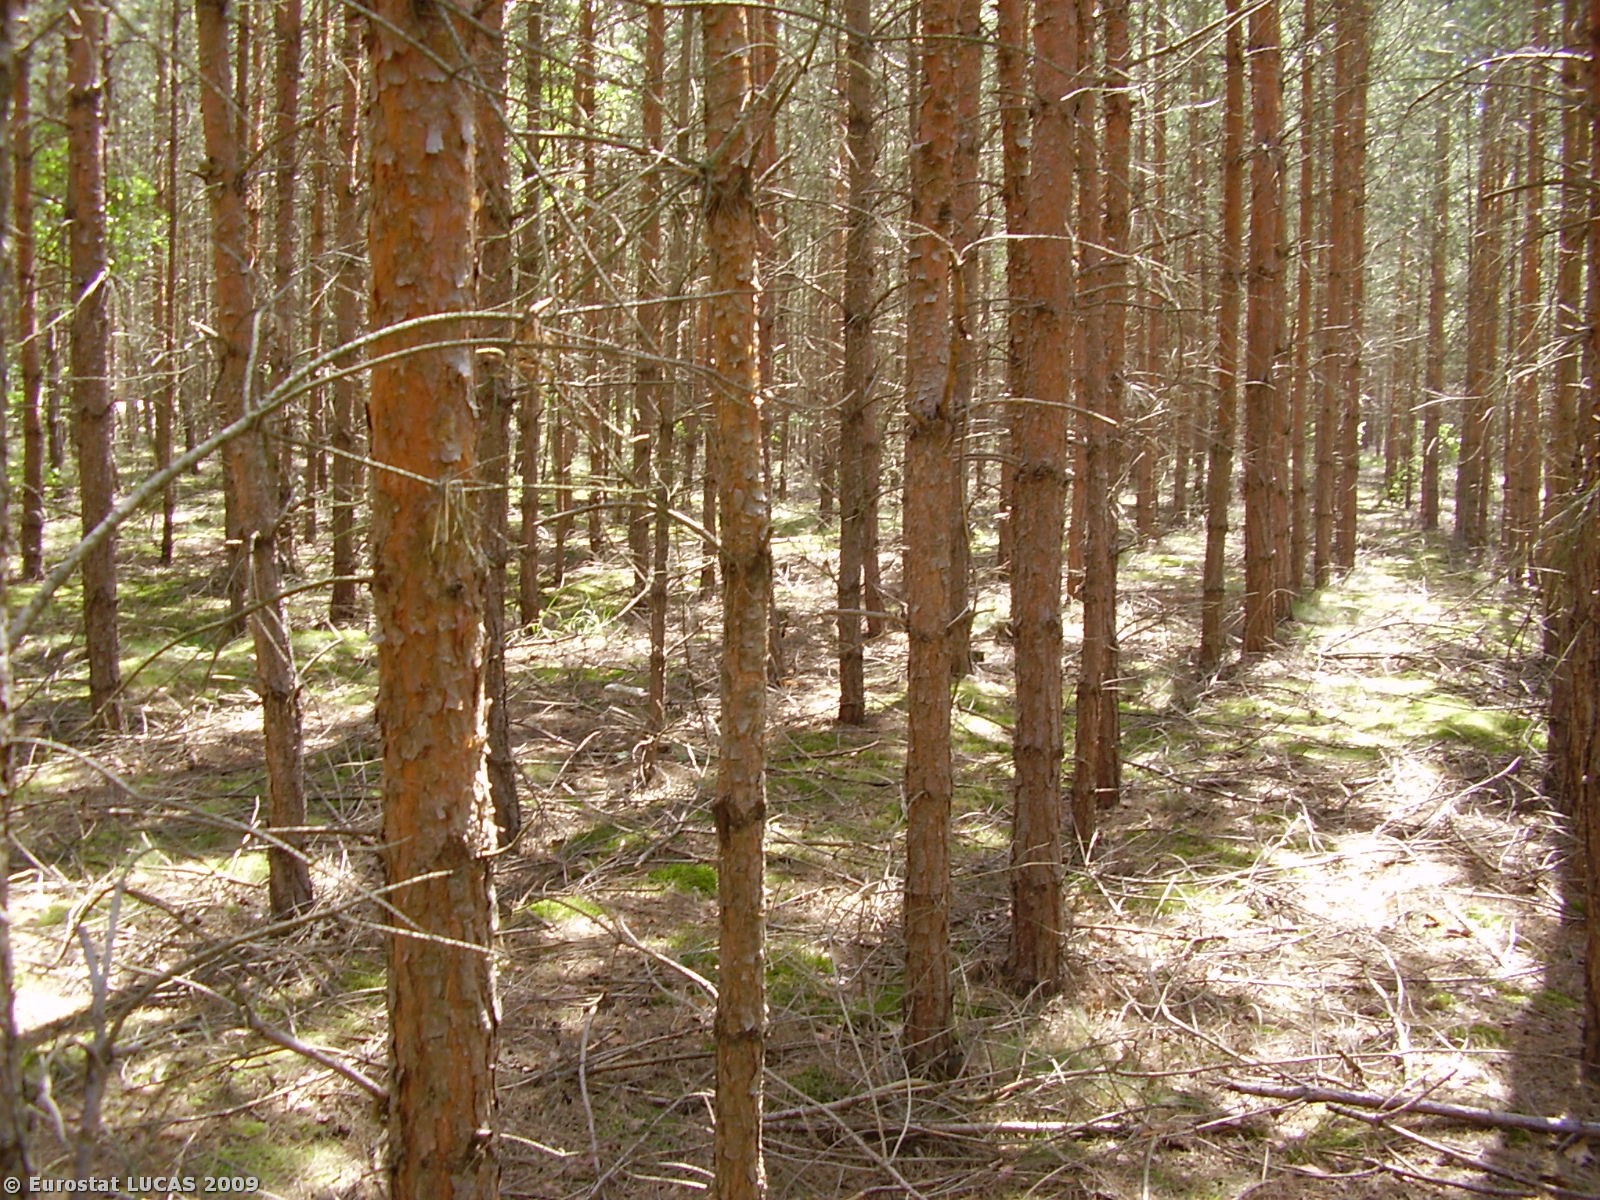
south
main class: Woodland
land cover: Coniferous woodland
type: hemiboreal forest and nemoral coniferous forest and mixed broadleaved-coniferous forest
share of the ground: > 75 %
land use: Forestry
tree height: > 5 m
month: July
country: PL
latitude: 51.8888
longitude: 16.2399
